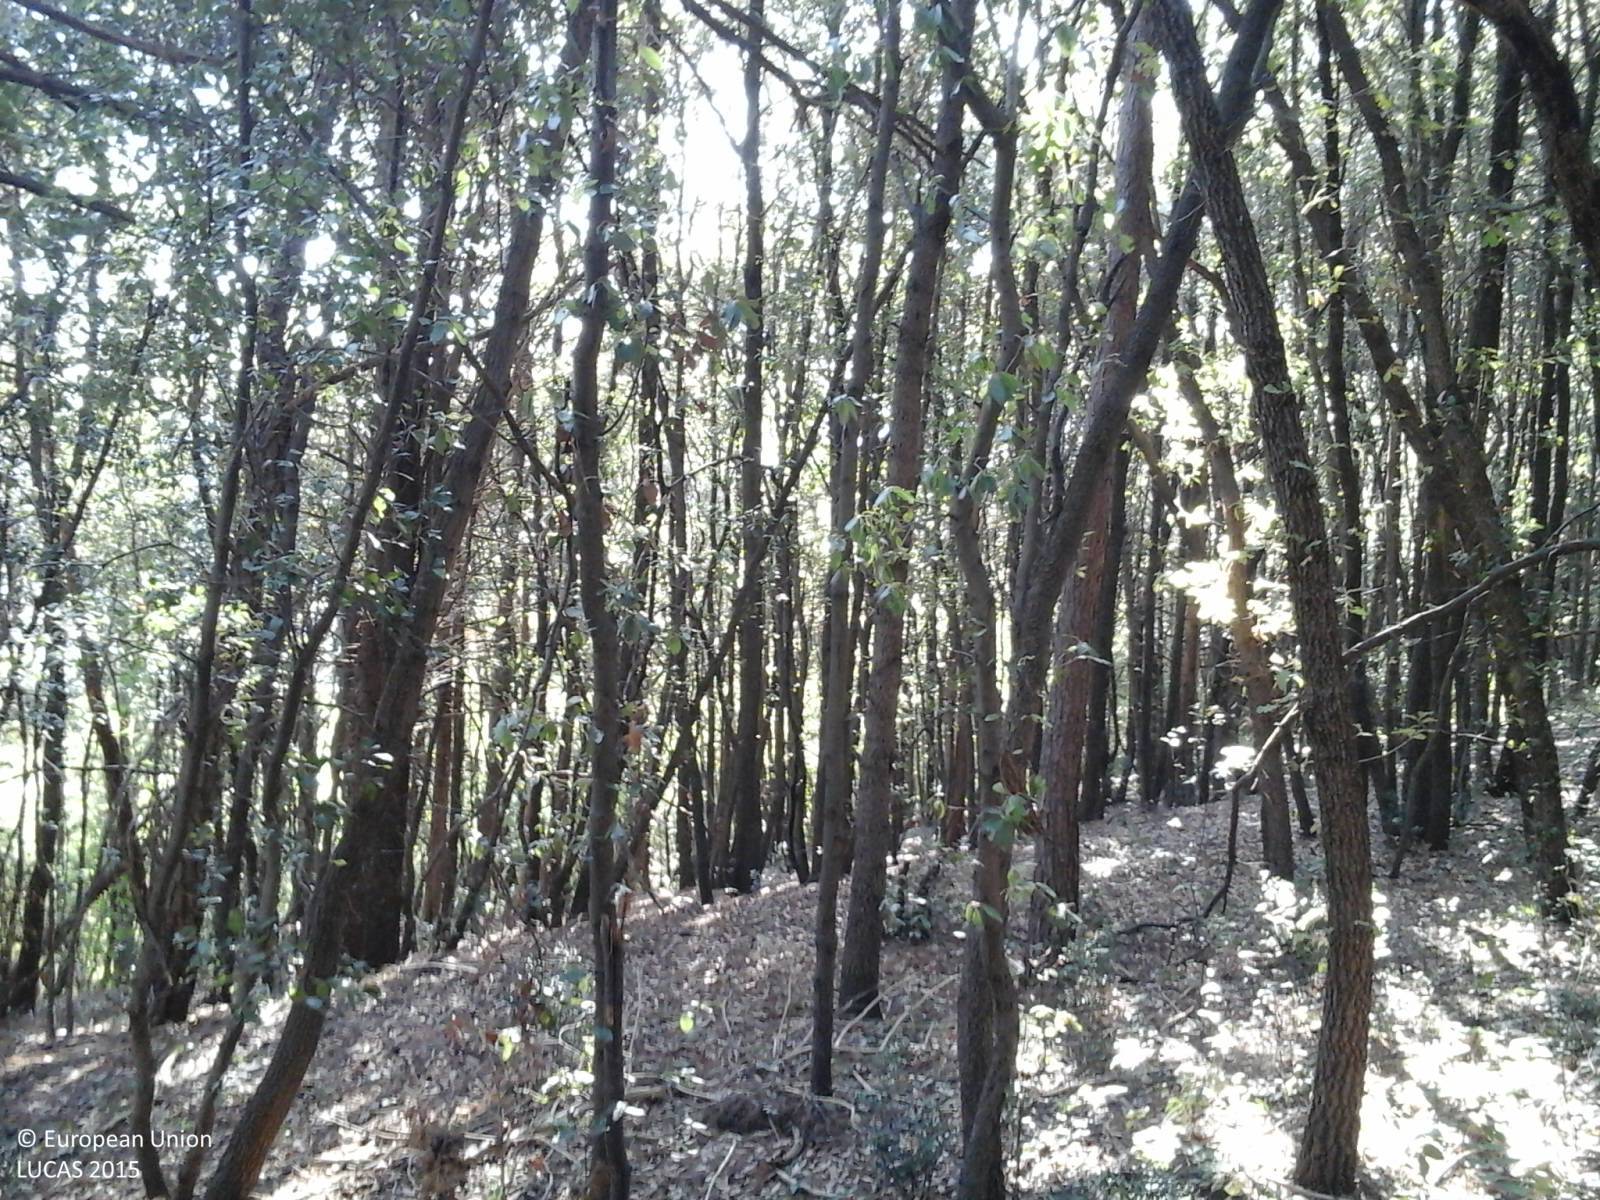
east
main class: Woodland
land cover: Other mixed woodland
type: thermophilous deciduous forest
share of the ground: > 75 %
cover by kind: coniferous forest trees 60 %, broadleaved forest trees 40 %
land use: Forestry
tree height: > 5 m
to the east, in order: Other mixed woodland; Broadleaved woodland
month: September
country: IT
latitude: 43.0967
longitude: 12.3398
